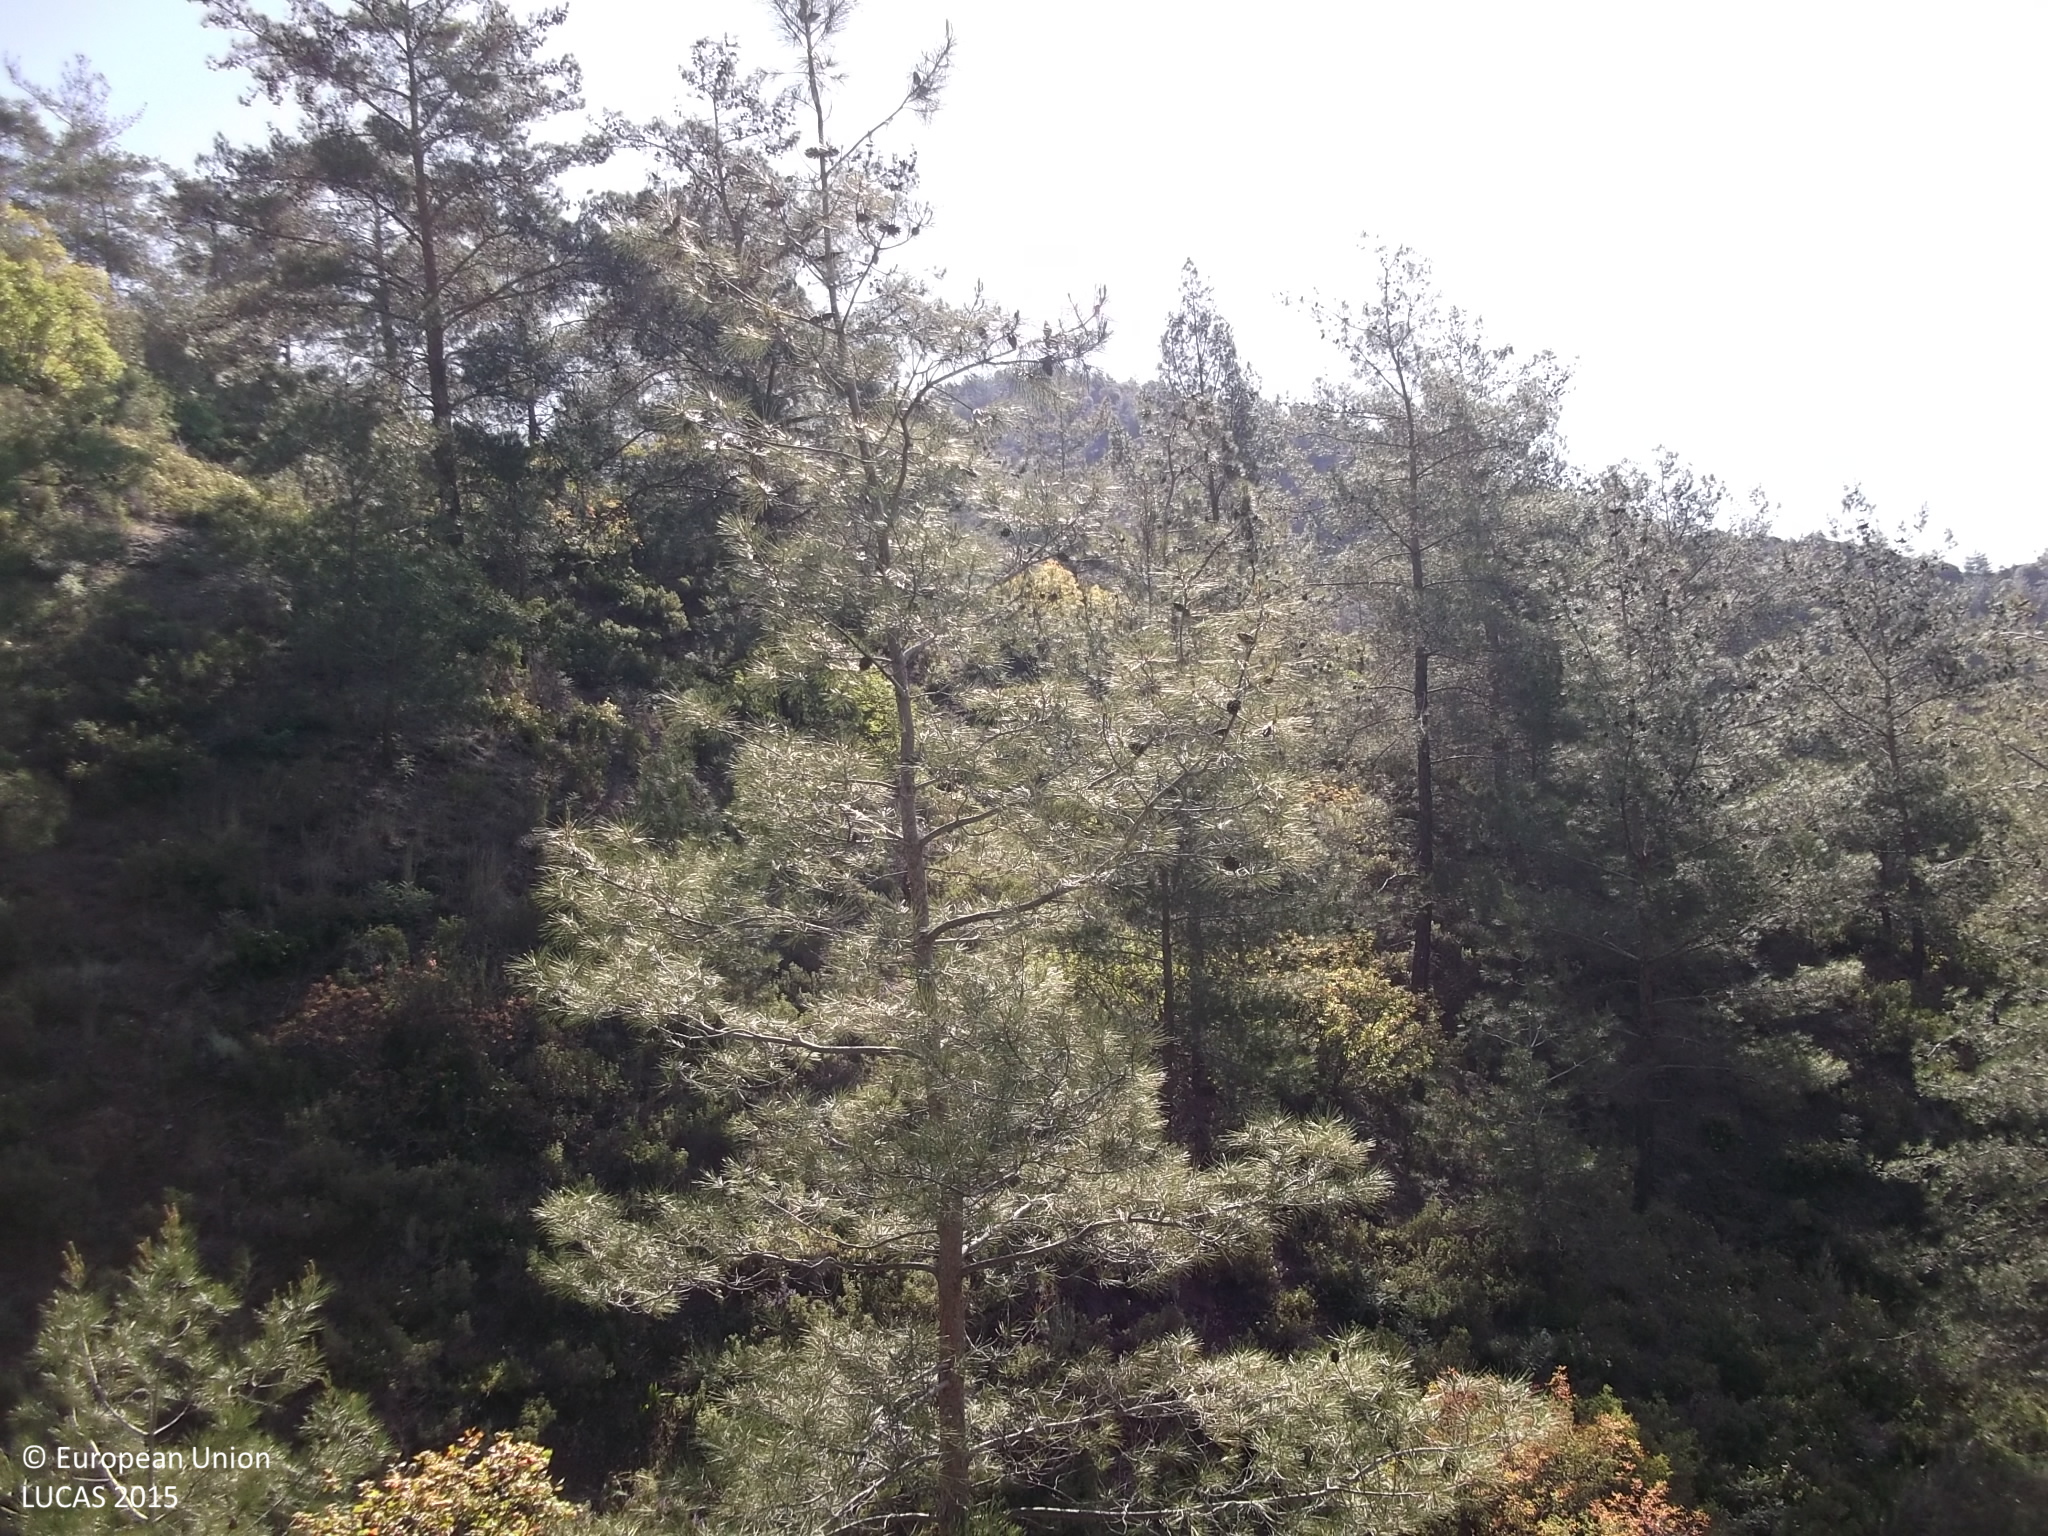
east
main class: Woodland
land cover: Pine dominated coniferous woodland
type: coniferous forest of the mediterranean region
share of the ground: 25 - 50 %
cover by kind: shrubs 50 %, coniferous forest trees 30 %, consolidated bare surface 10 %, unconsolidated bare surface 10 %
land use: Semi-natural and natural areas not in use
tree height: > 5 m
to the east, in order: Pine dominated coniferous woodland; Shrubland with sparse tree cover; Pine dominated coniferous woodland; Shrubland with sparse tree cover; Broadleaved woodland; Rivers and streams; Broadleaved woodland
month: April
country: CY
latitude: 34.8821
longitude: 33.0952
